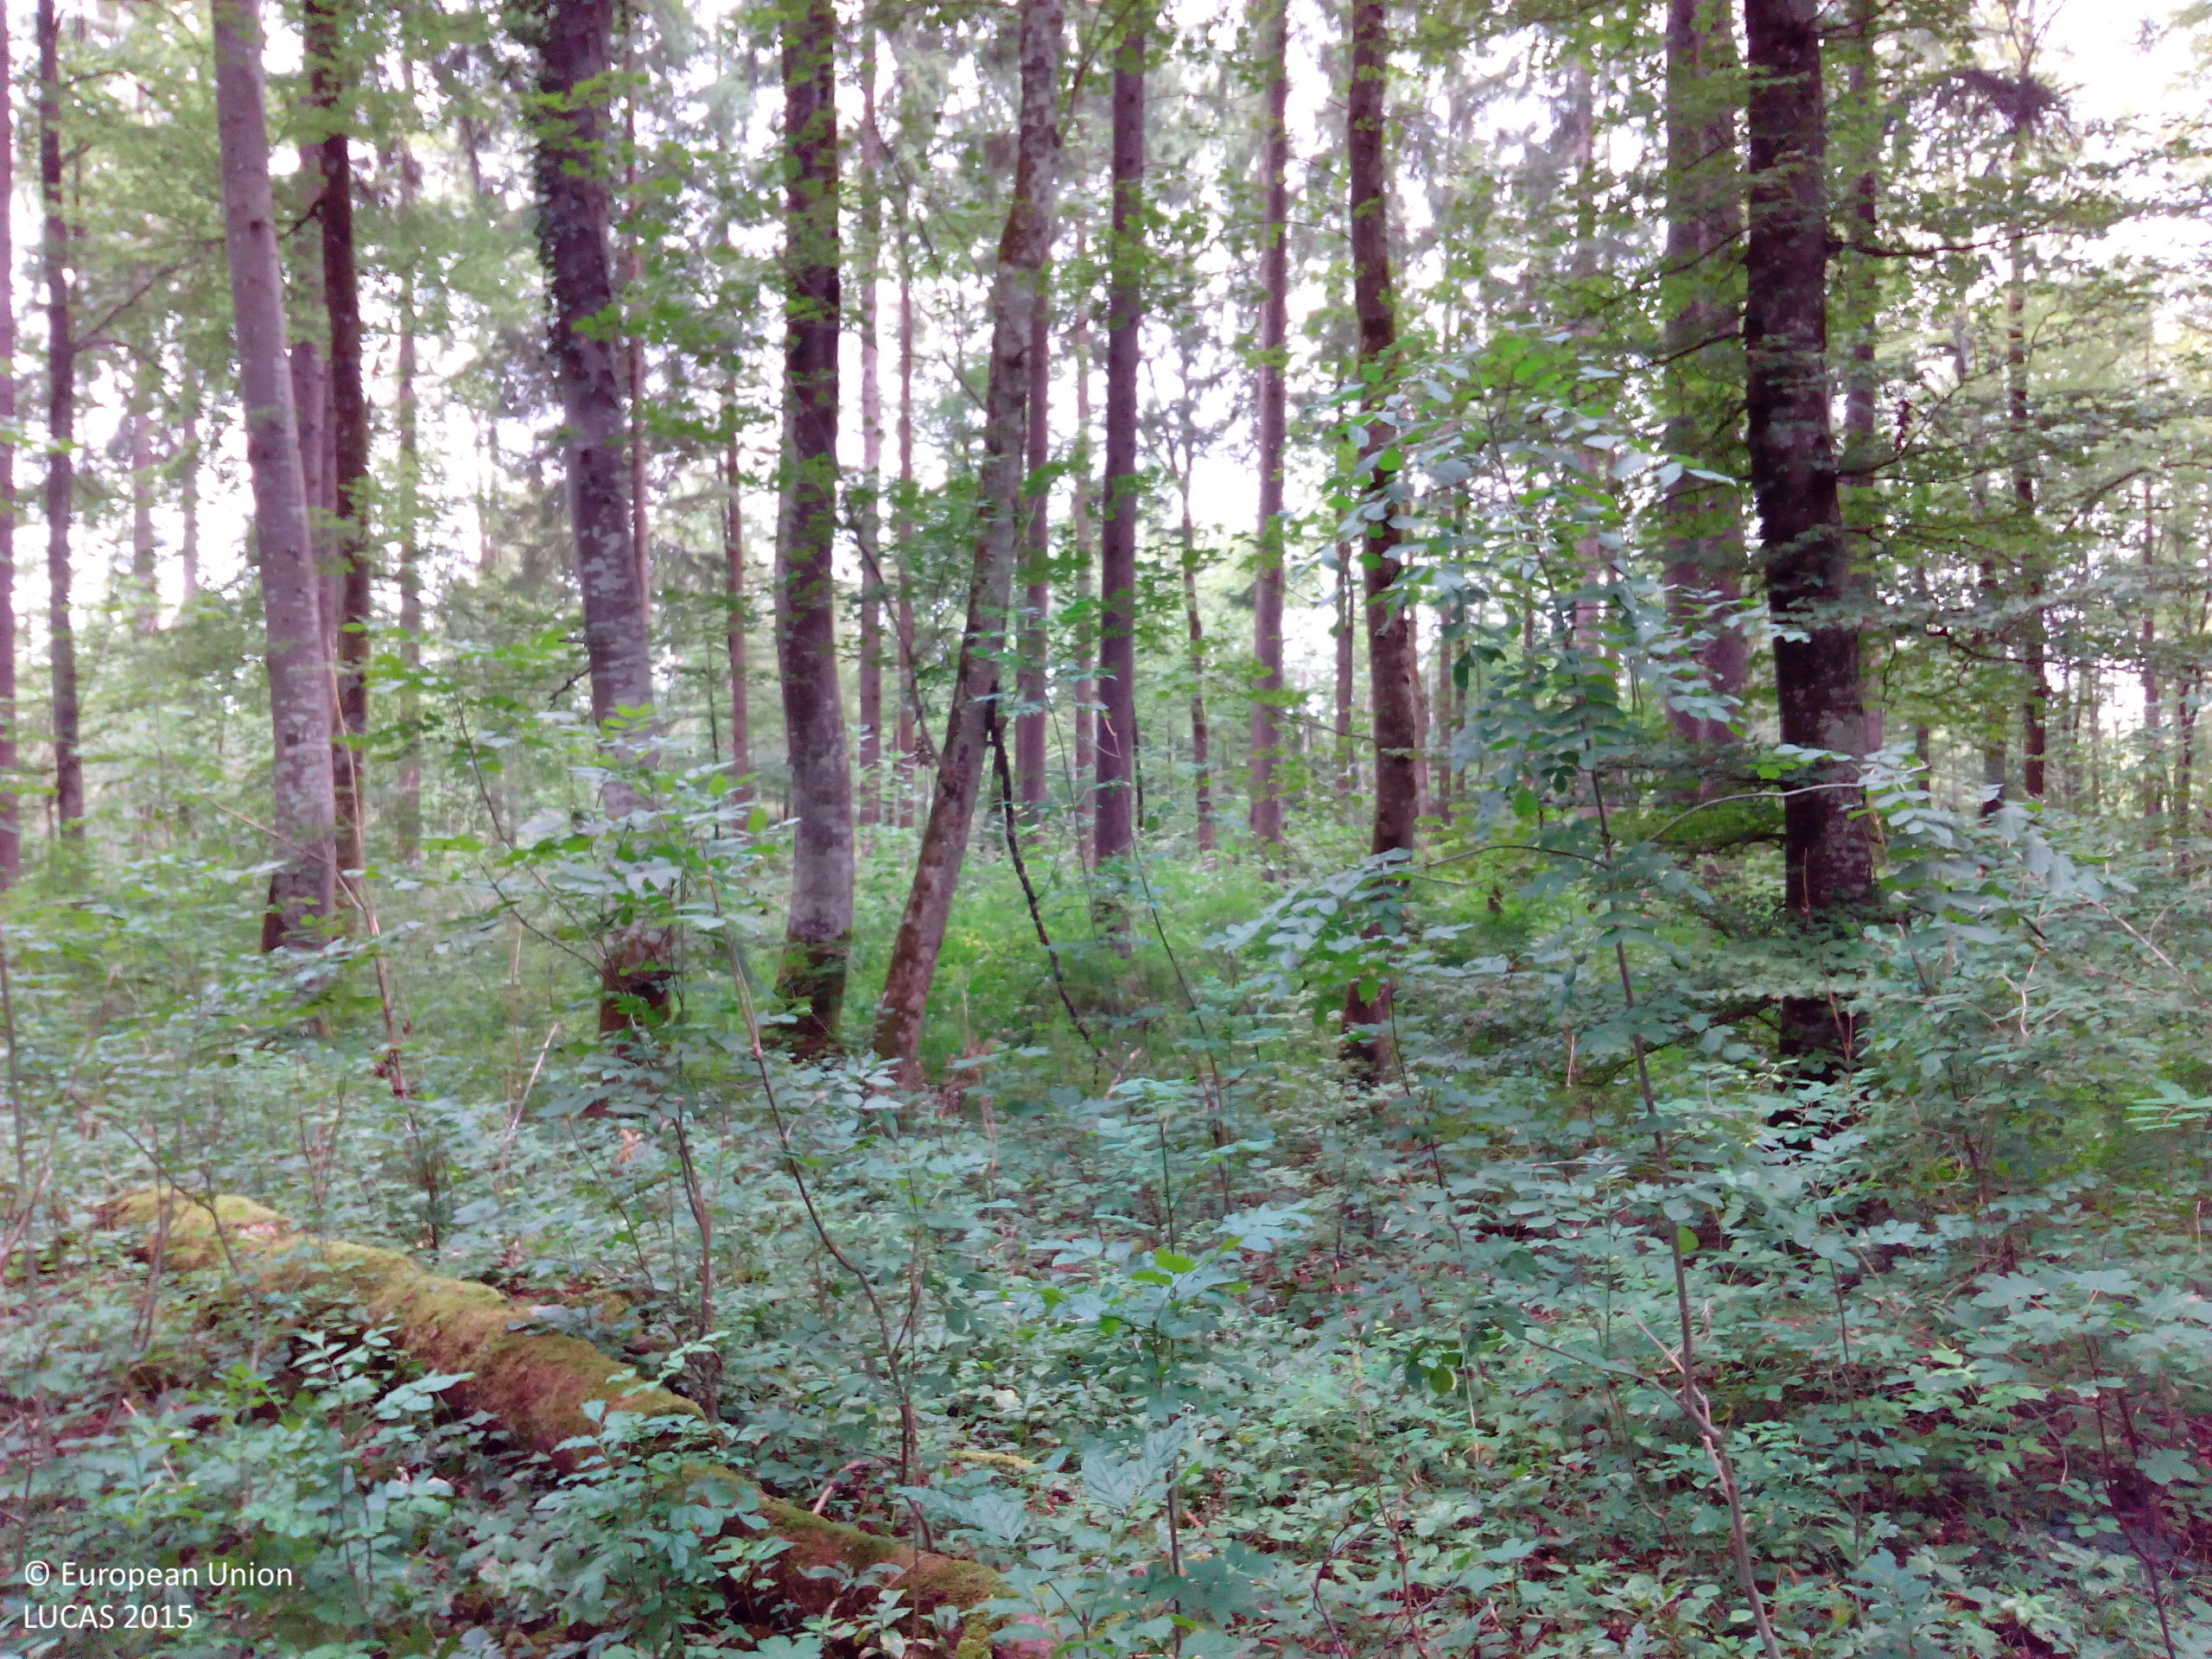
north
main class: Woodland
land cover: Broadleaved woodland
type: beech forest
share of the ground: 50 - 75 %
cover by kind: broadleaved forest trees 70 %, shrubs 10 %, herbaceous plants 10 %, lichens and mosses 5 %, unconsolidated bare surface 5 %
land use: Forestry
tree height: > 5 m
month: July
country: DE
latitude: 47.8363
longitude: 8.5714
